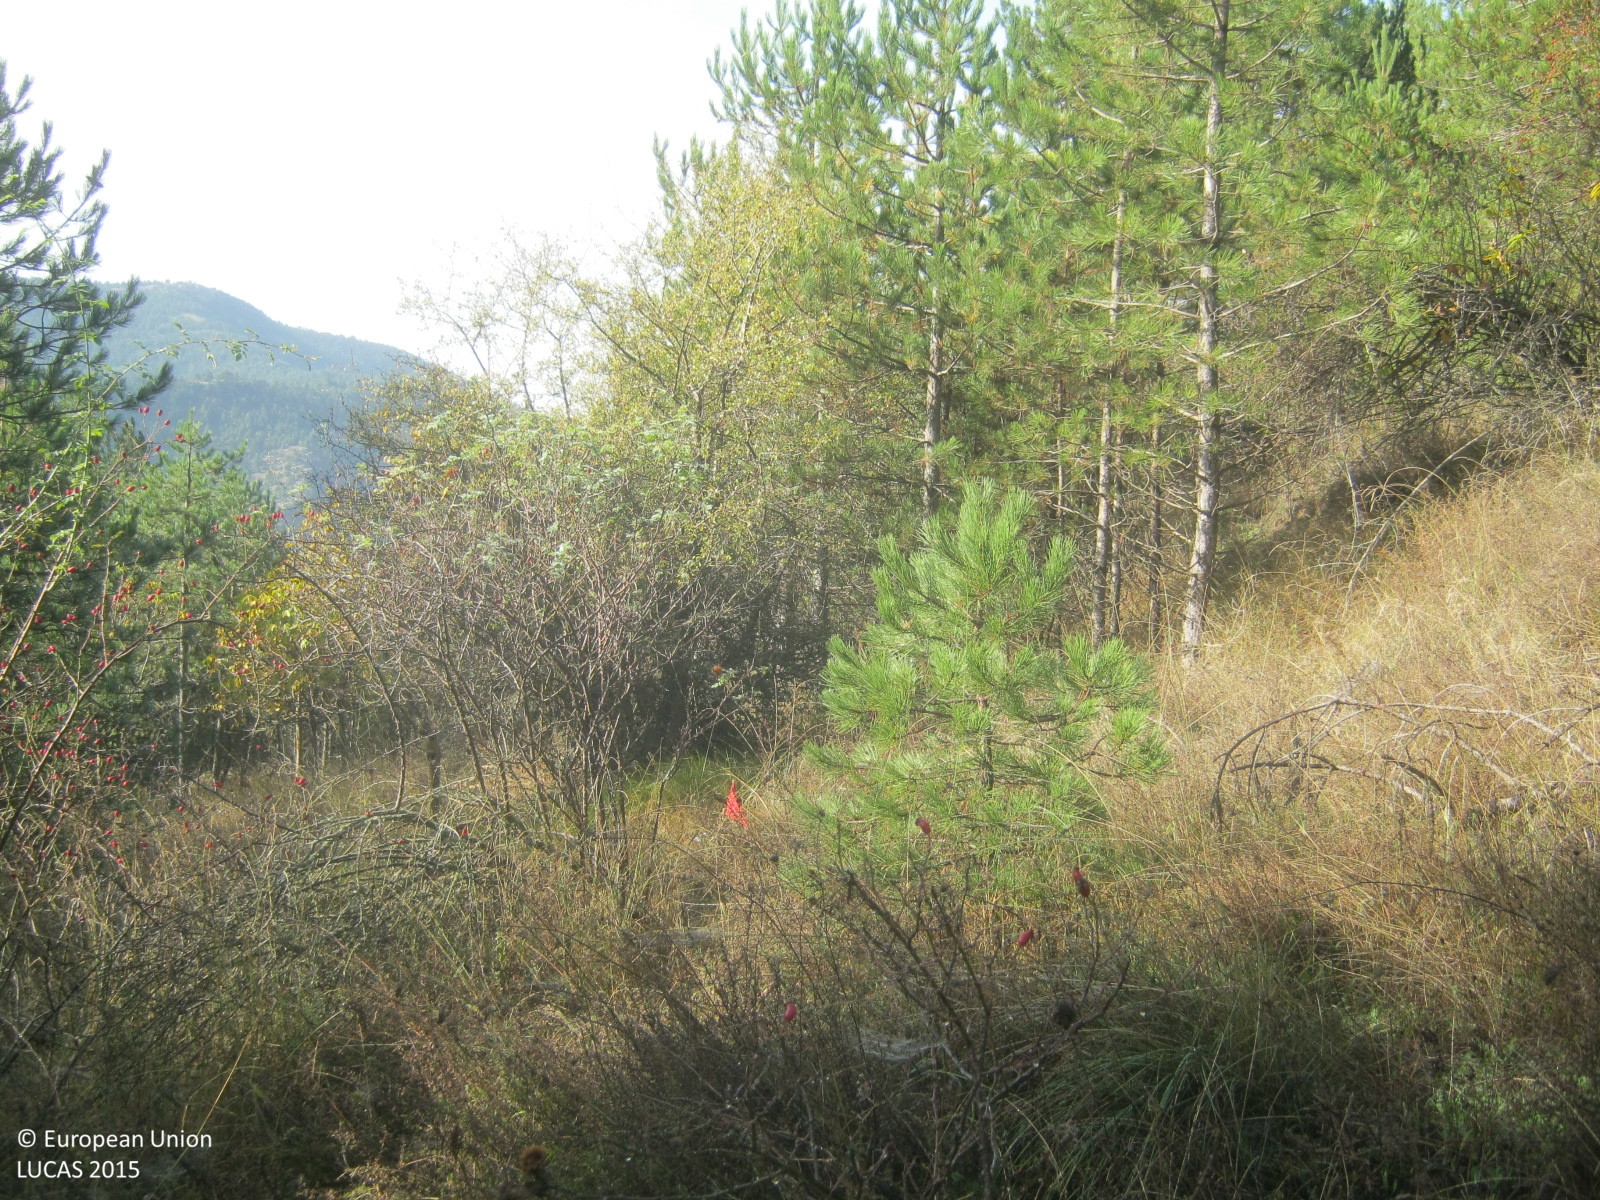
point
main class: Woodland
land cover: Pine dominated mixed woodland
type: coniferous forest of the mediterranean region
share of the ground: > 75 %
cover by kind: coniferous forest trees 60 %, broadleaved forest trees 25 %, herbaceous plants 15 %
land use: Forestry
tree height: > 5 m
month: October
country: GR
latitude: 38.0112
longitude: 22.4180
